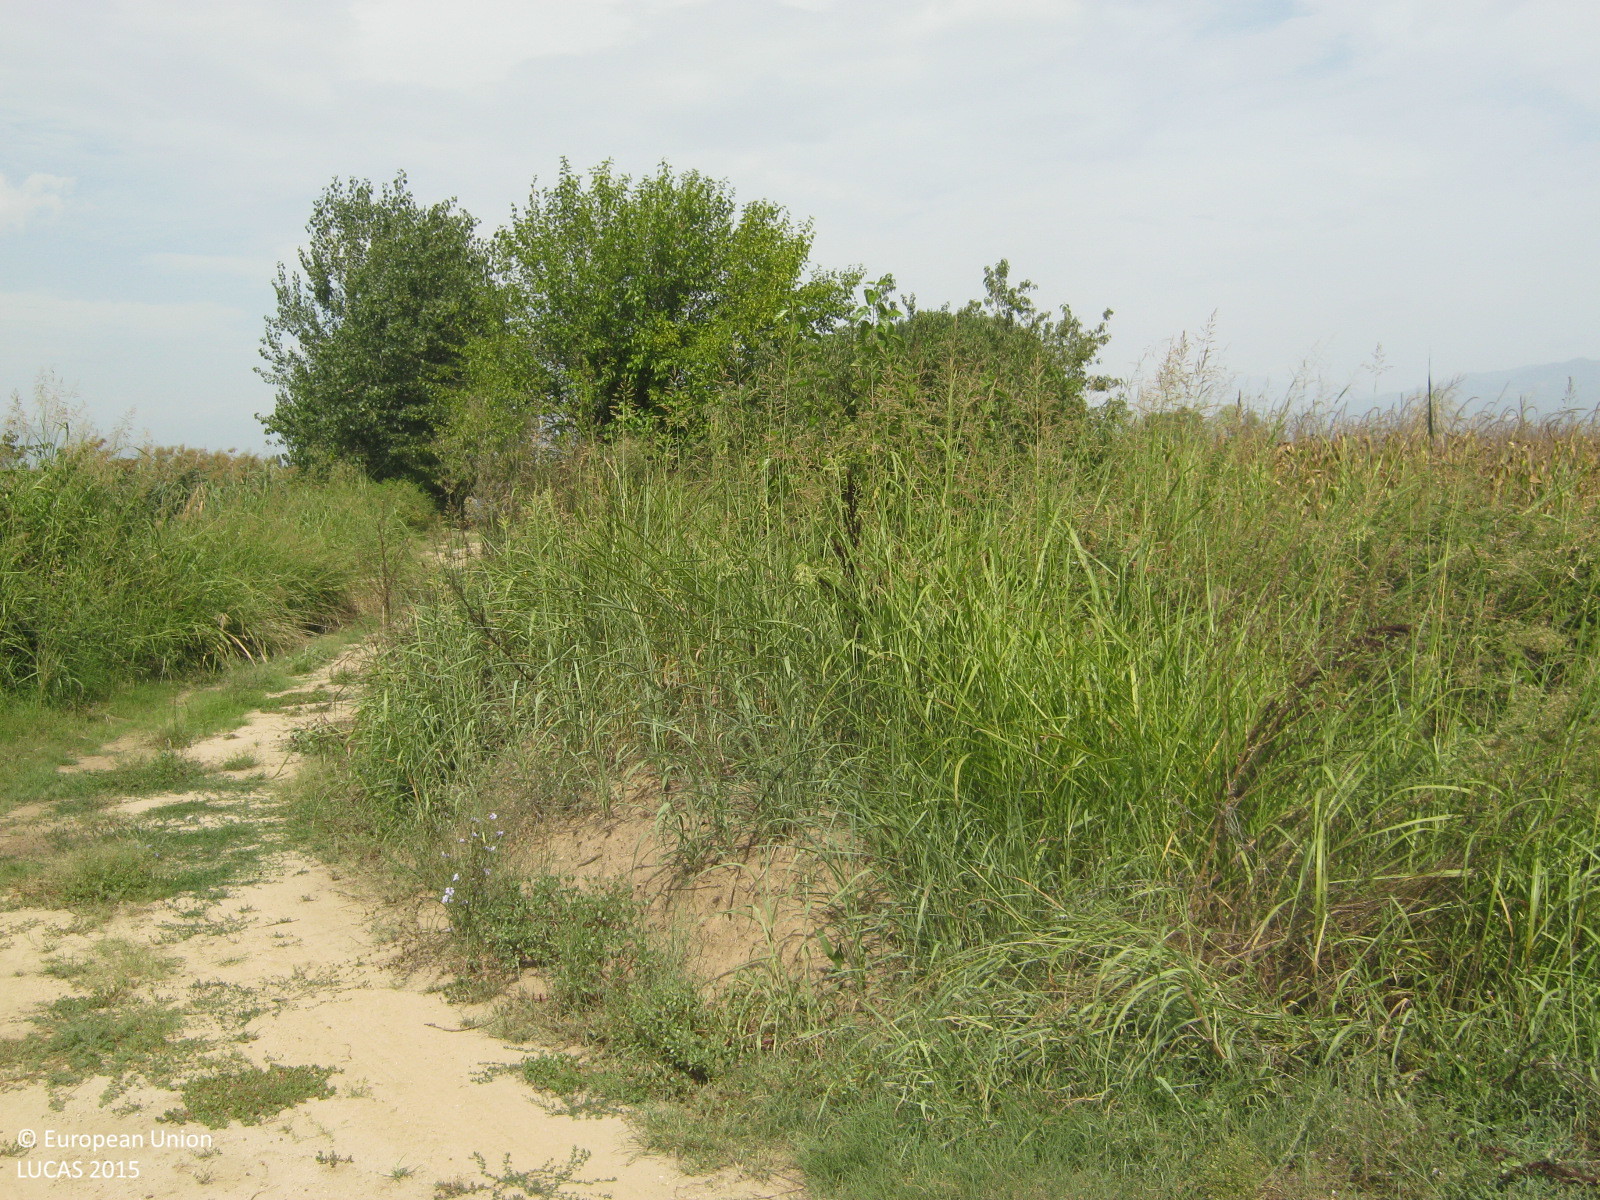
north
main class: Woodland
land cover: Broadleaved woodland
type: floodplain forest
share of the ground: 50 - 75 %
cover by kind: broadleaved forest trees 70 %, herbaceous plants 20 %, shrubs 10 %
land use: Forestry
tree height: < 5 m
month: September
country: GR
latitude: 41.0971
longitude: 23.2919
